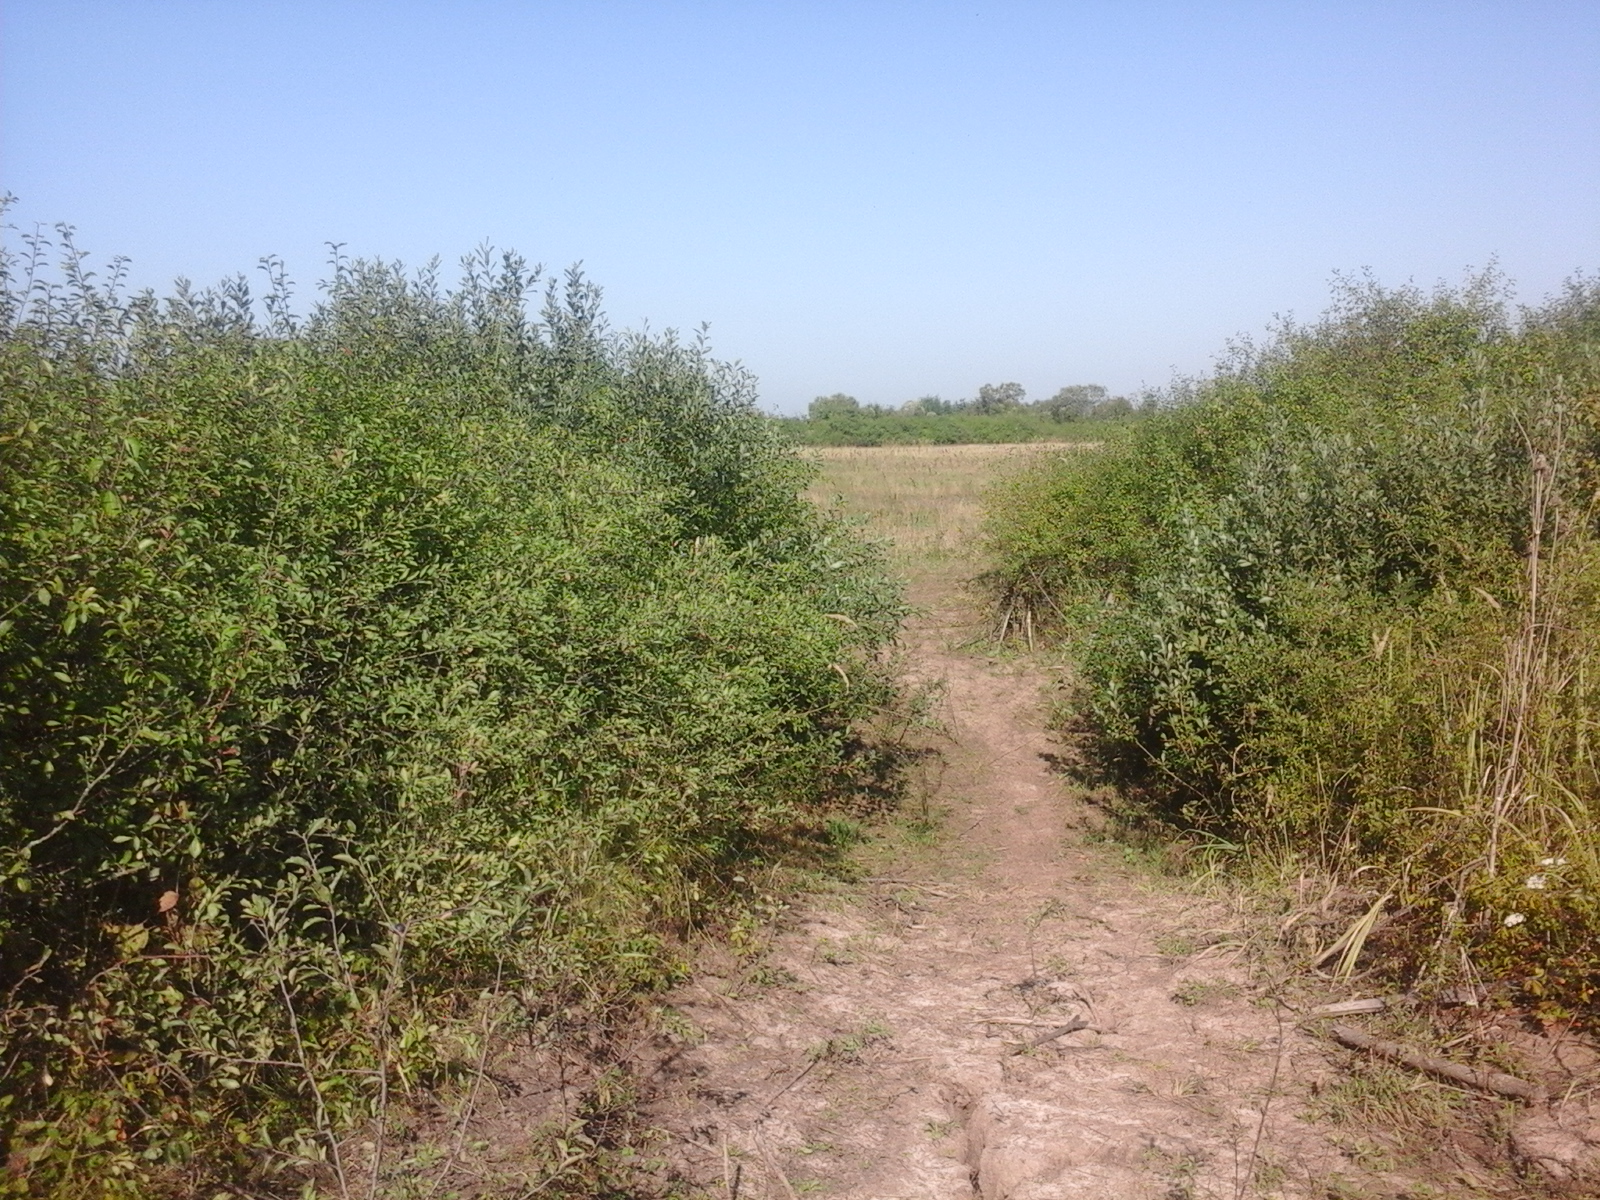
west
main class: Shrubland
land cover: Shrubland with sparse tree cover
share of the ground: > 75 %
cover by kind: shrubs 95 %, broadleaved forest trees 5 %
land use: Semi-natural and natural areas not in use
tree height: < 5 m
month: August
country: RO
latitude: 45.6876
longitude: 21.7078
